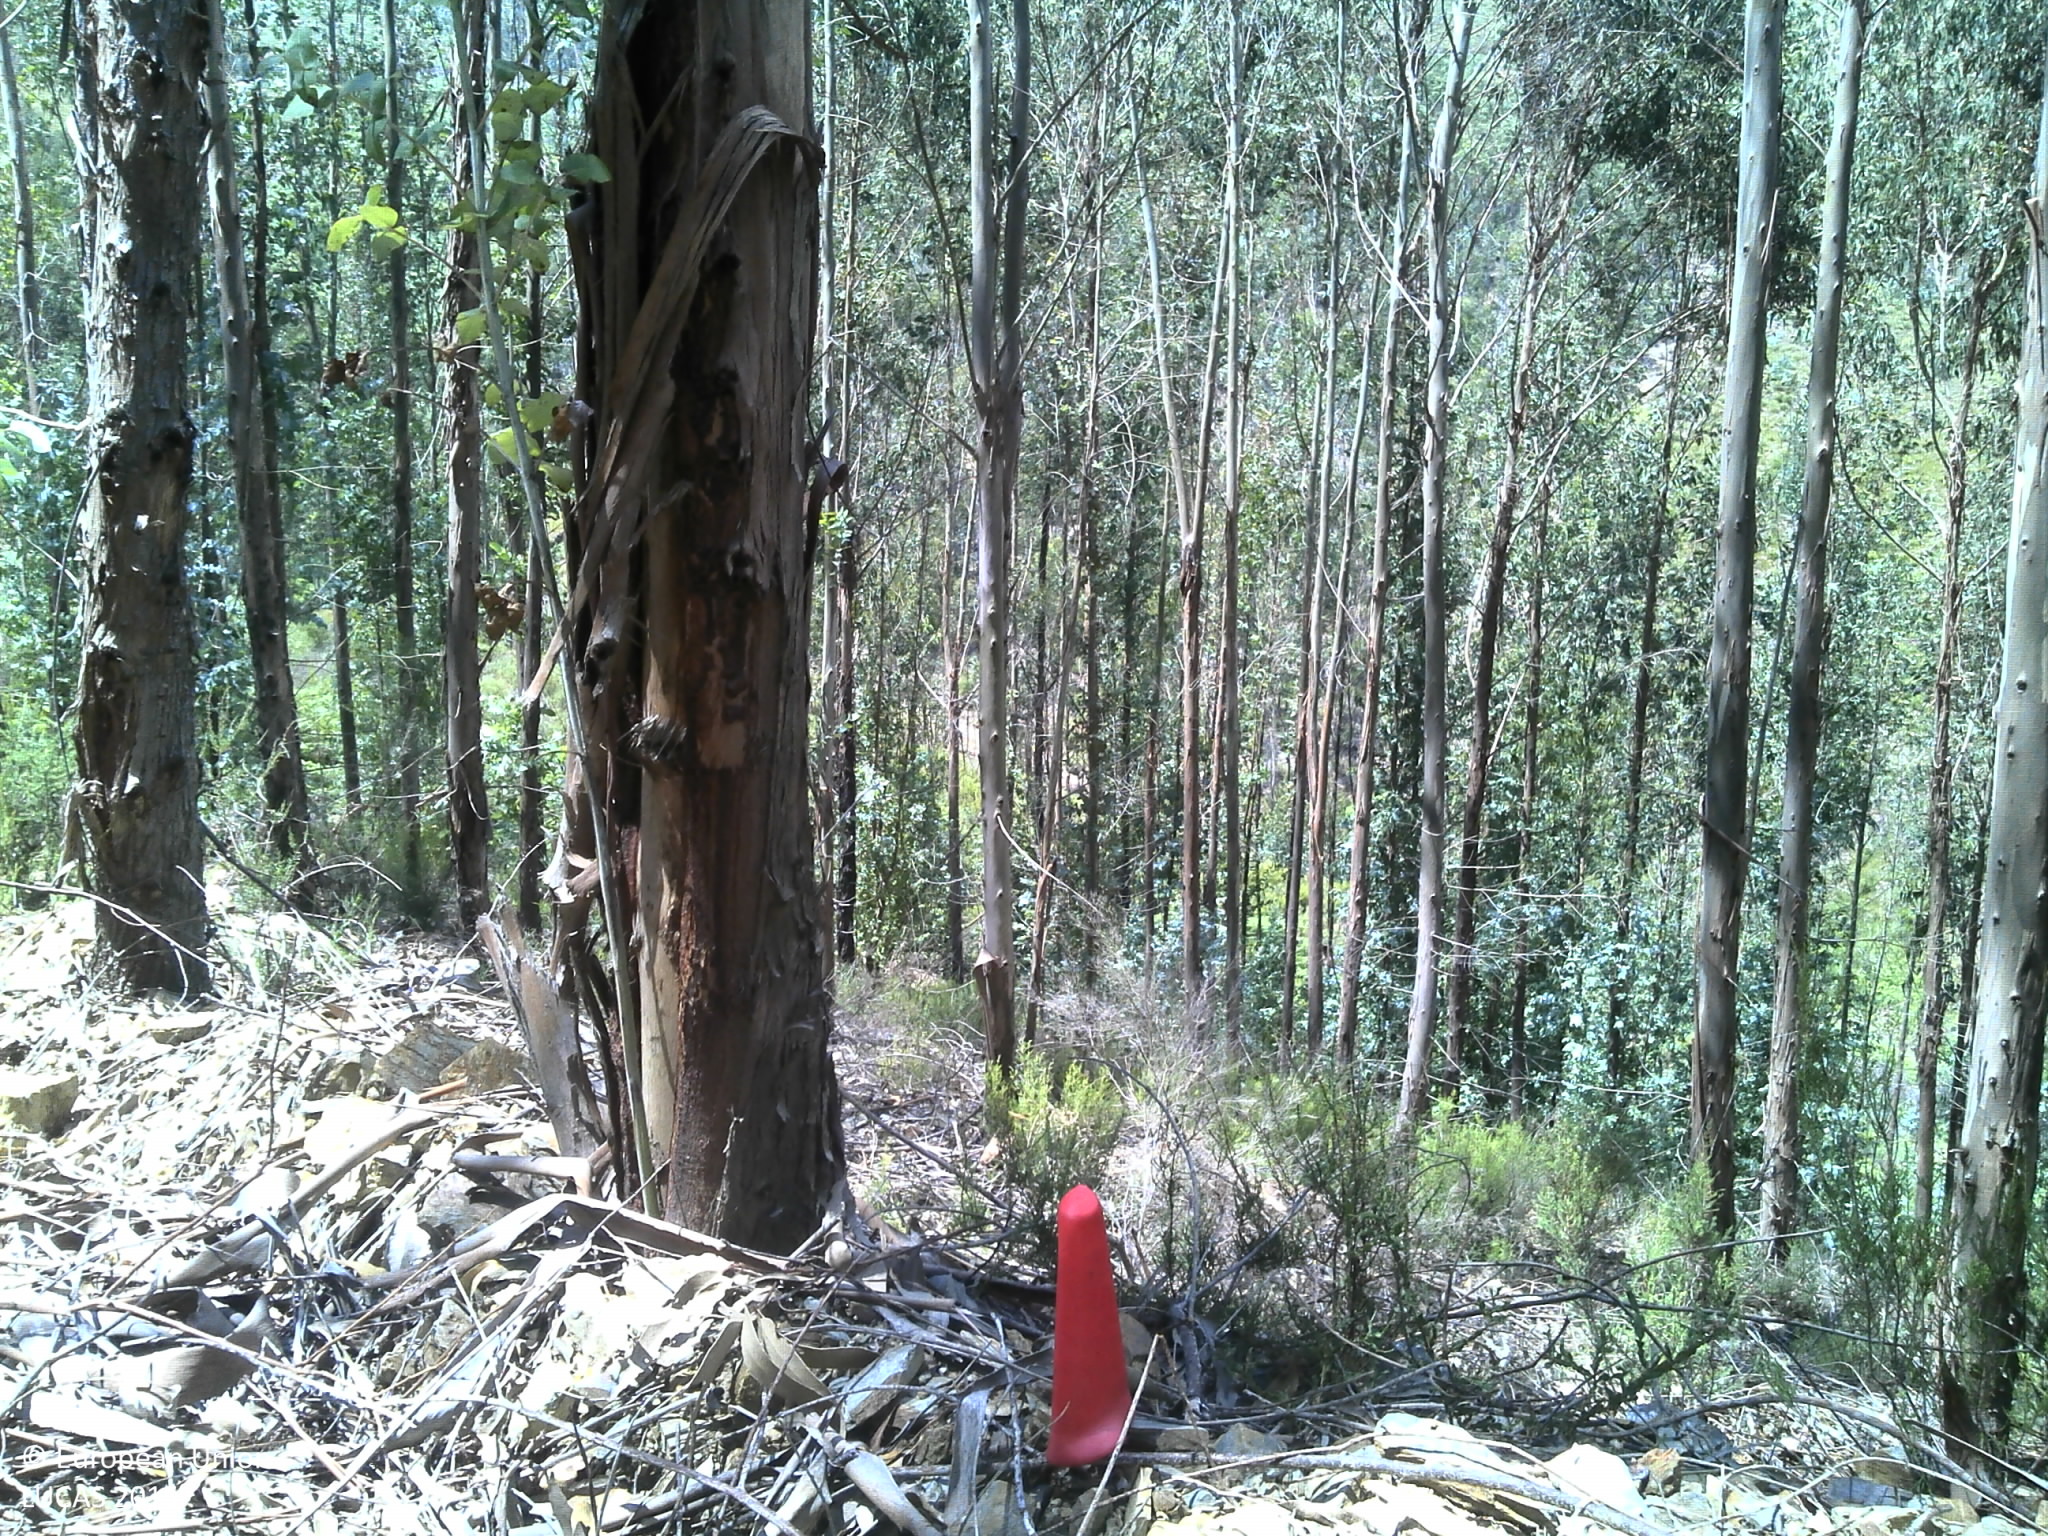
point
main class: Woodland
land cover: Broadleaved woodland
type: exotic forest
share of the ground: > 75 %
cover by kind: broadleaved forest trees 75 %, shrubs 15 %, unconsolidated bare surface 10 %
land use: Forestry
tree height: > 5 m
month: June
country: PT
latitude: 40.9194
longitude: -8.0749
